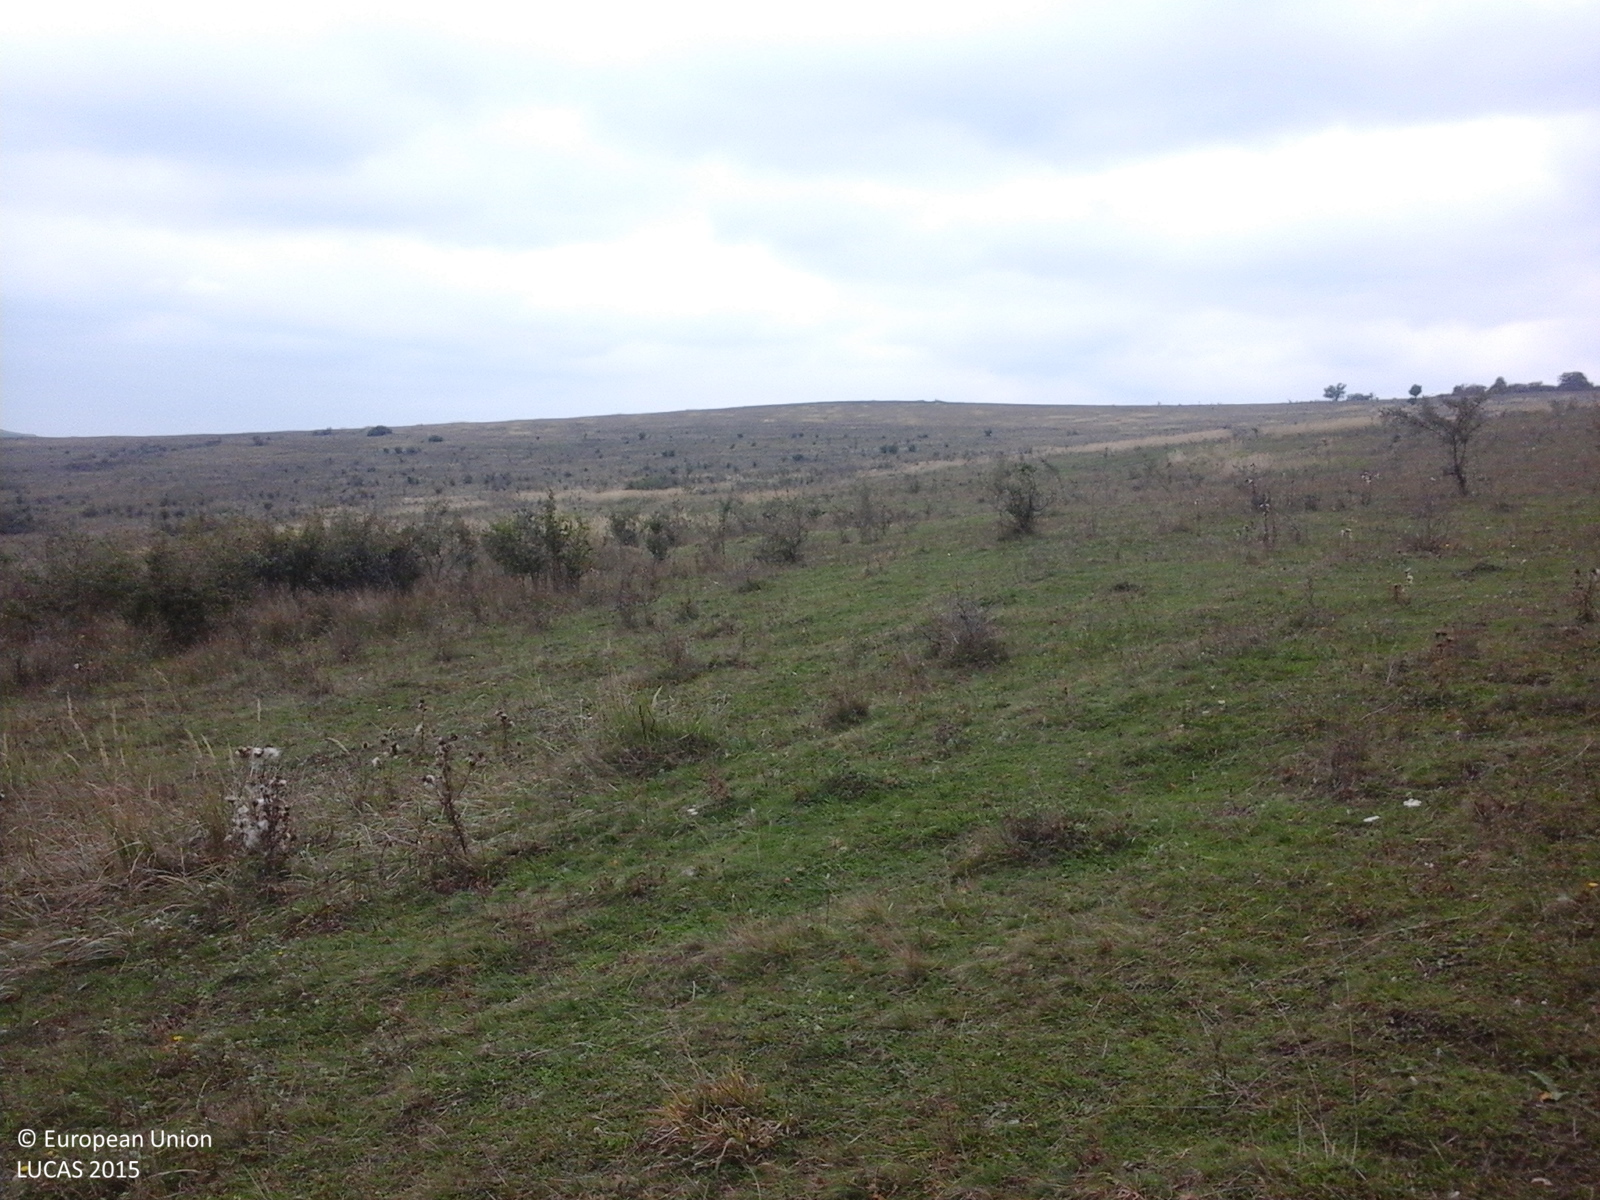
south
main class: Grassland
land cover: Grassland with sparse tree/shrub cover
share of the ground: > 75 %
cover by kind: herbaceous plants 85 %, shrubs 10 %, broadleaved forest trees 5 %
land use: Fallow land
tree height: < 5 m
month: October
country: RO
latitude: 46.0547
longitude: 25.1289
